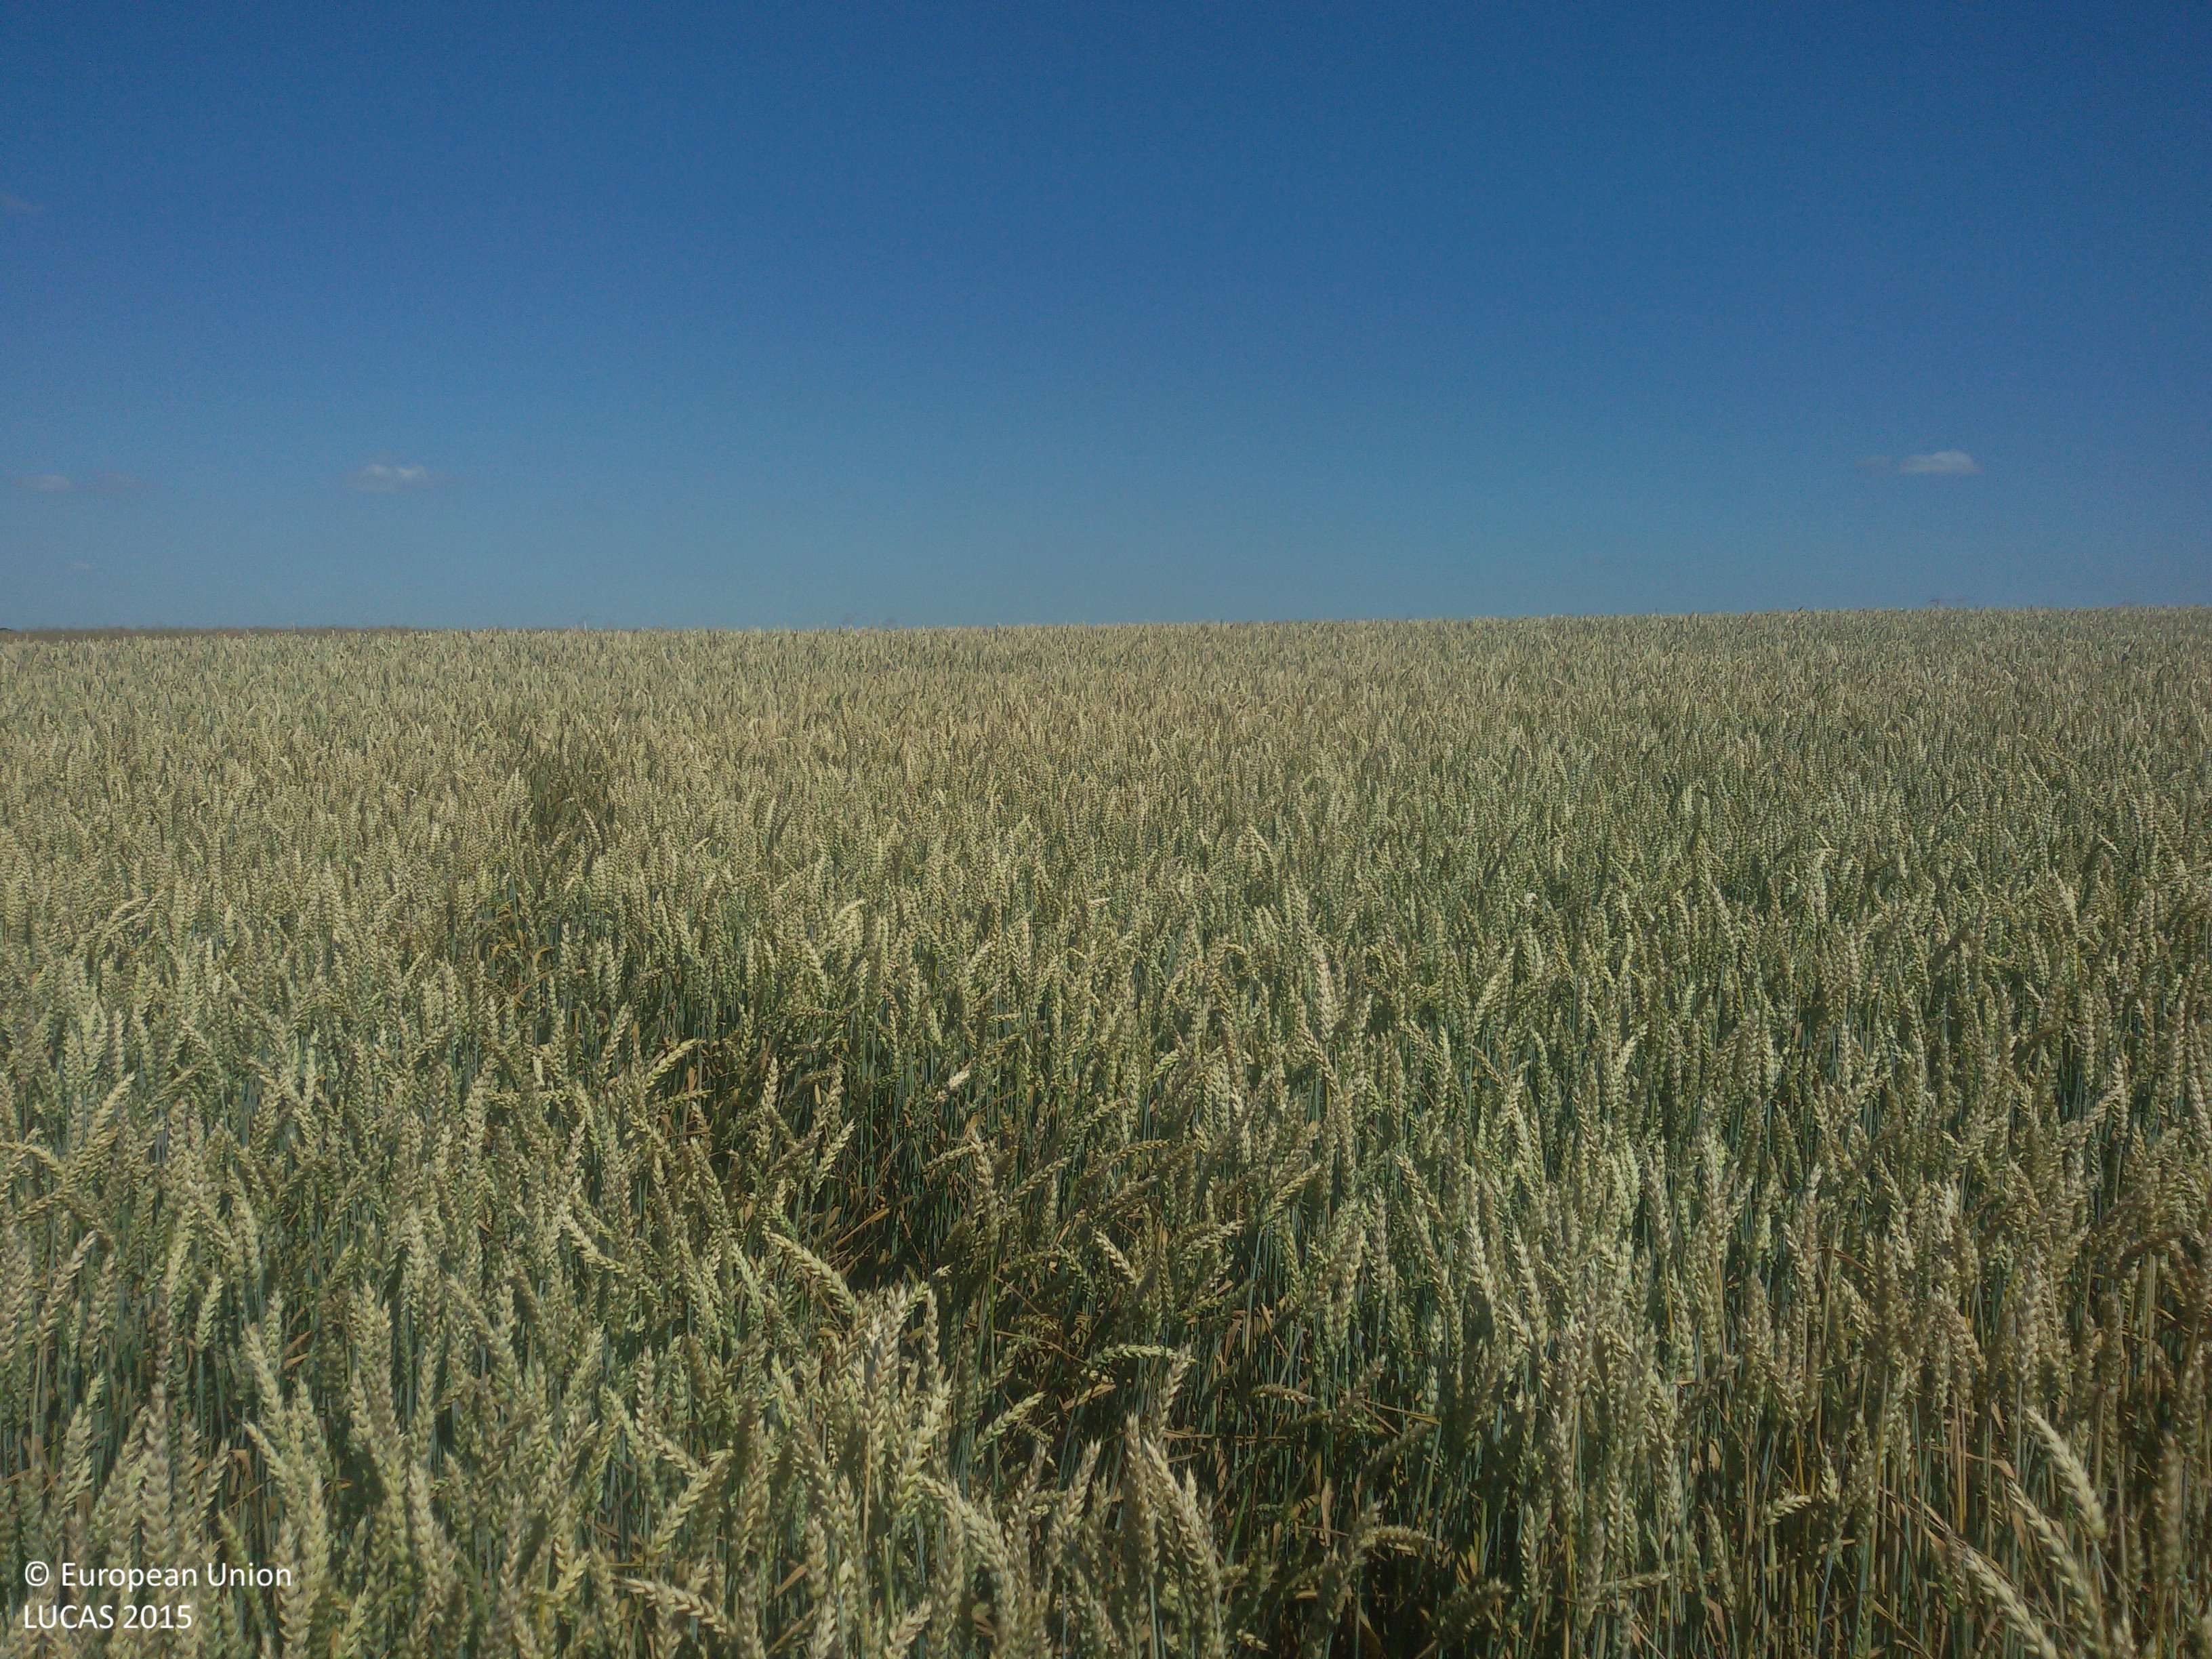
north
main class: Cropland
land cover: Common wheat
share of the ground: > 75 %
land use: Agriculture (excluding fallow land and kitchen gardens)
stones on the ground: < 10 %
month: July
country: PL
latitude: 50.3984
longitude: 17.6242
